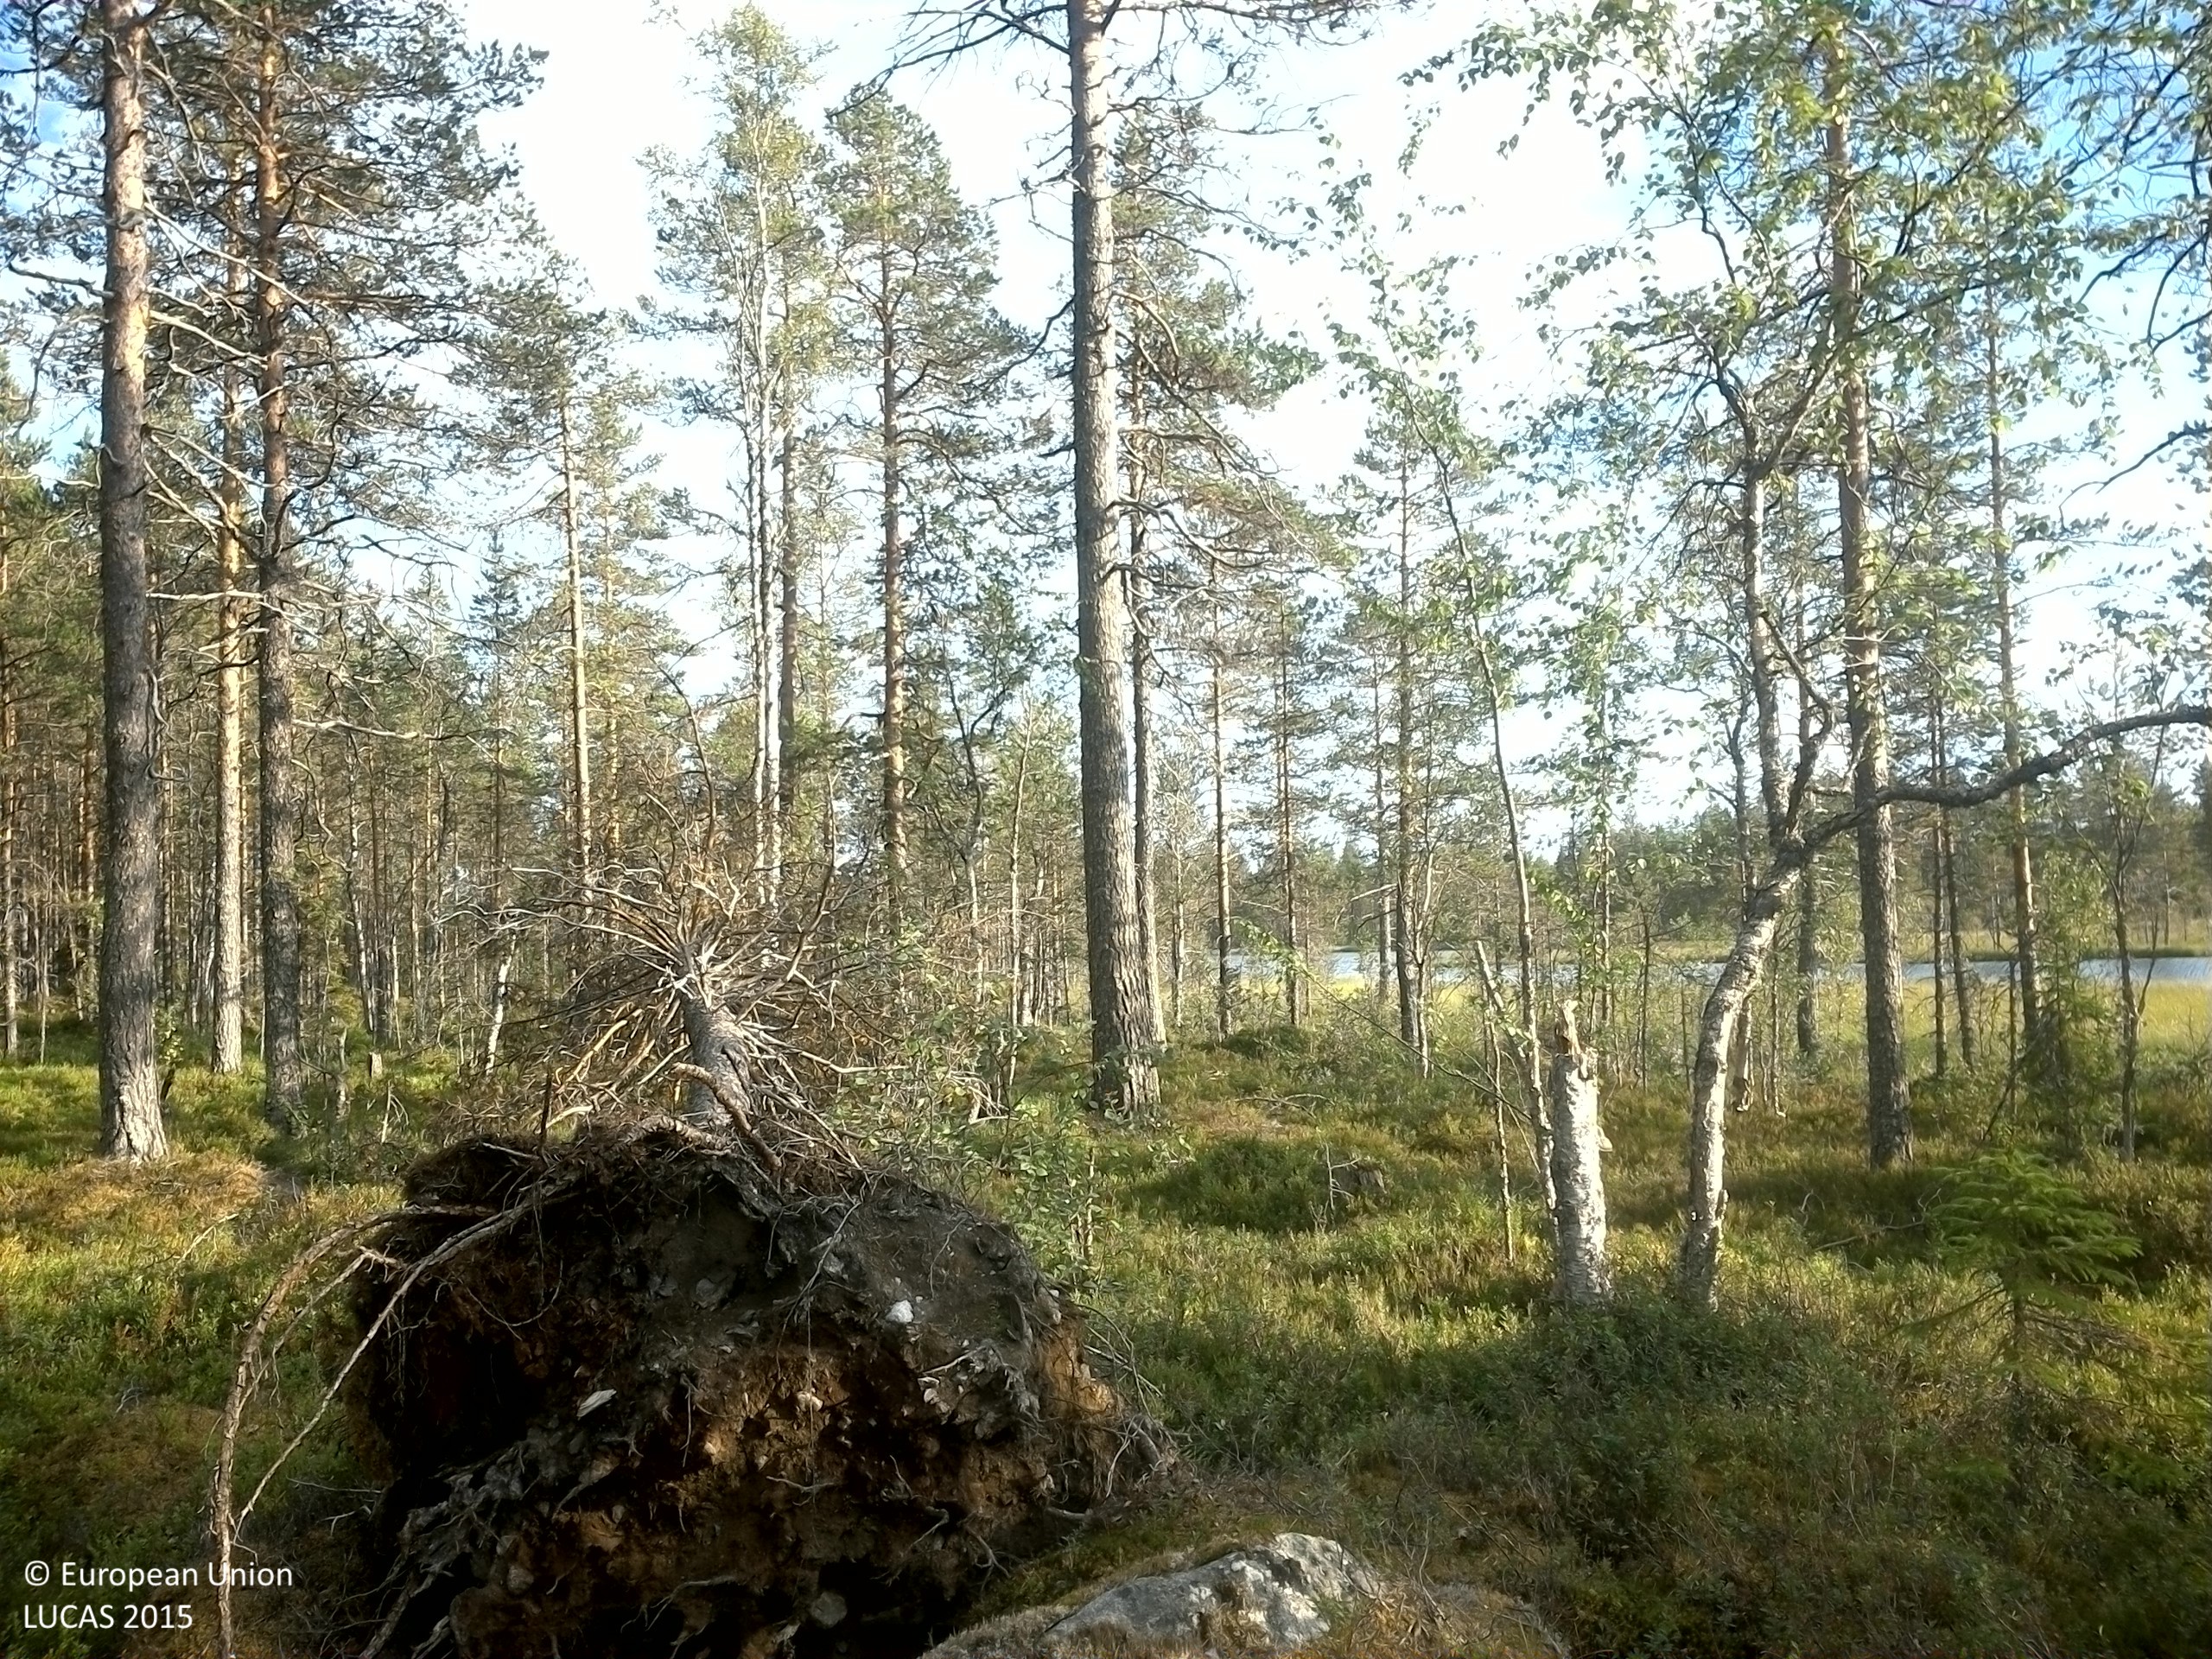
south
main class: Woodland
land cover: Pine dominated mixed woodland
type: boreal forest
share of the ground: 25 - 50 %
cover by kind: shrubs 40 %, coniferous forest trees 35 %, broadleaved forest trees 15 %, herbaceous plants 5 %, lichens and mosses 5 %
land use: Forestry
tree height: > 5 m
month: August
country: SE
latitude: 62.8503
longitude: 16.9508
